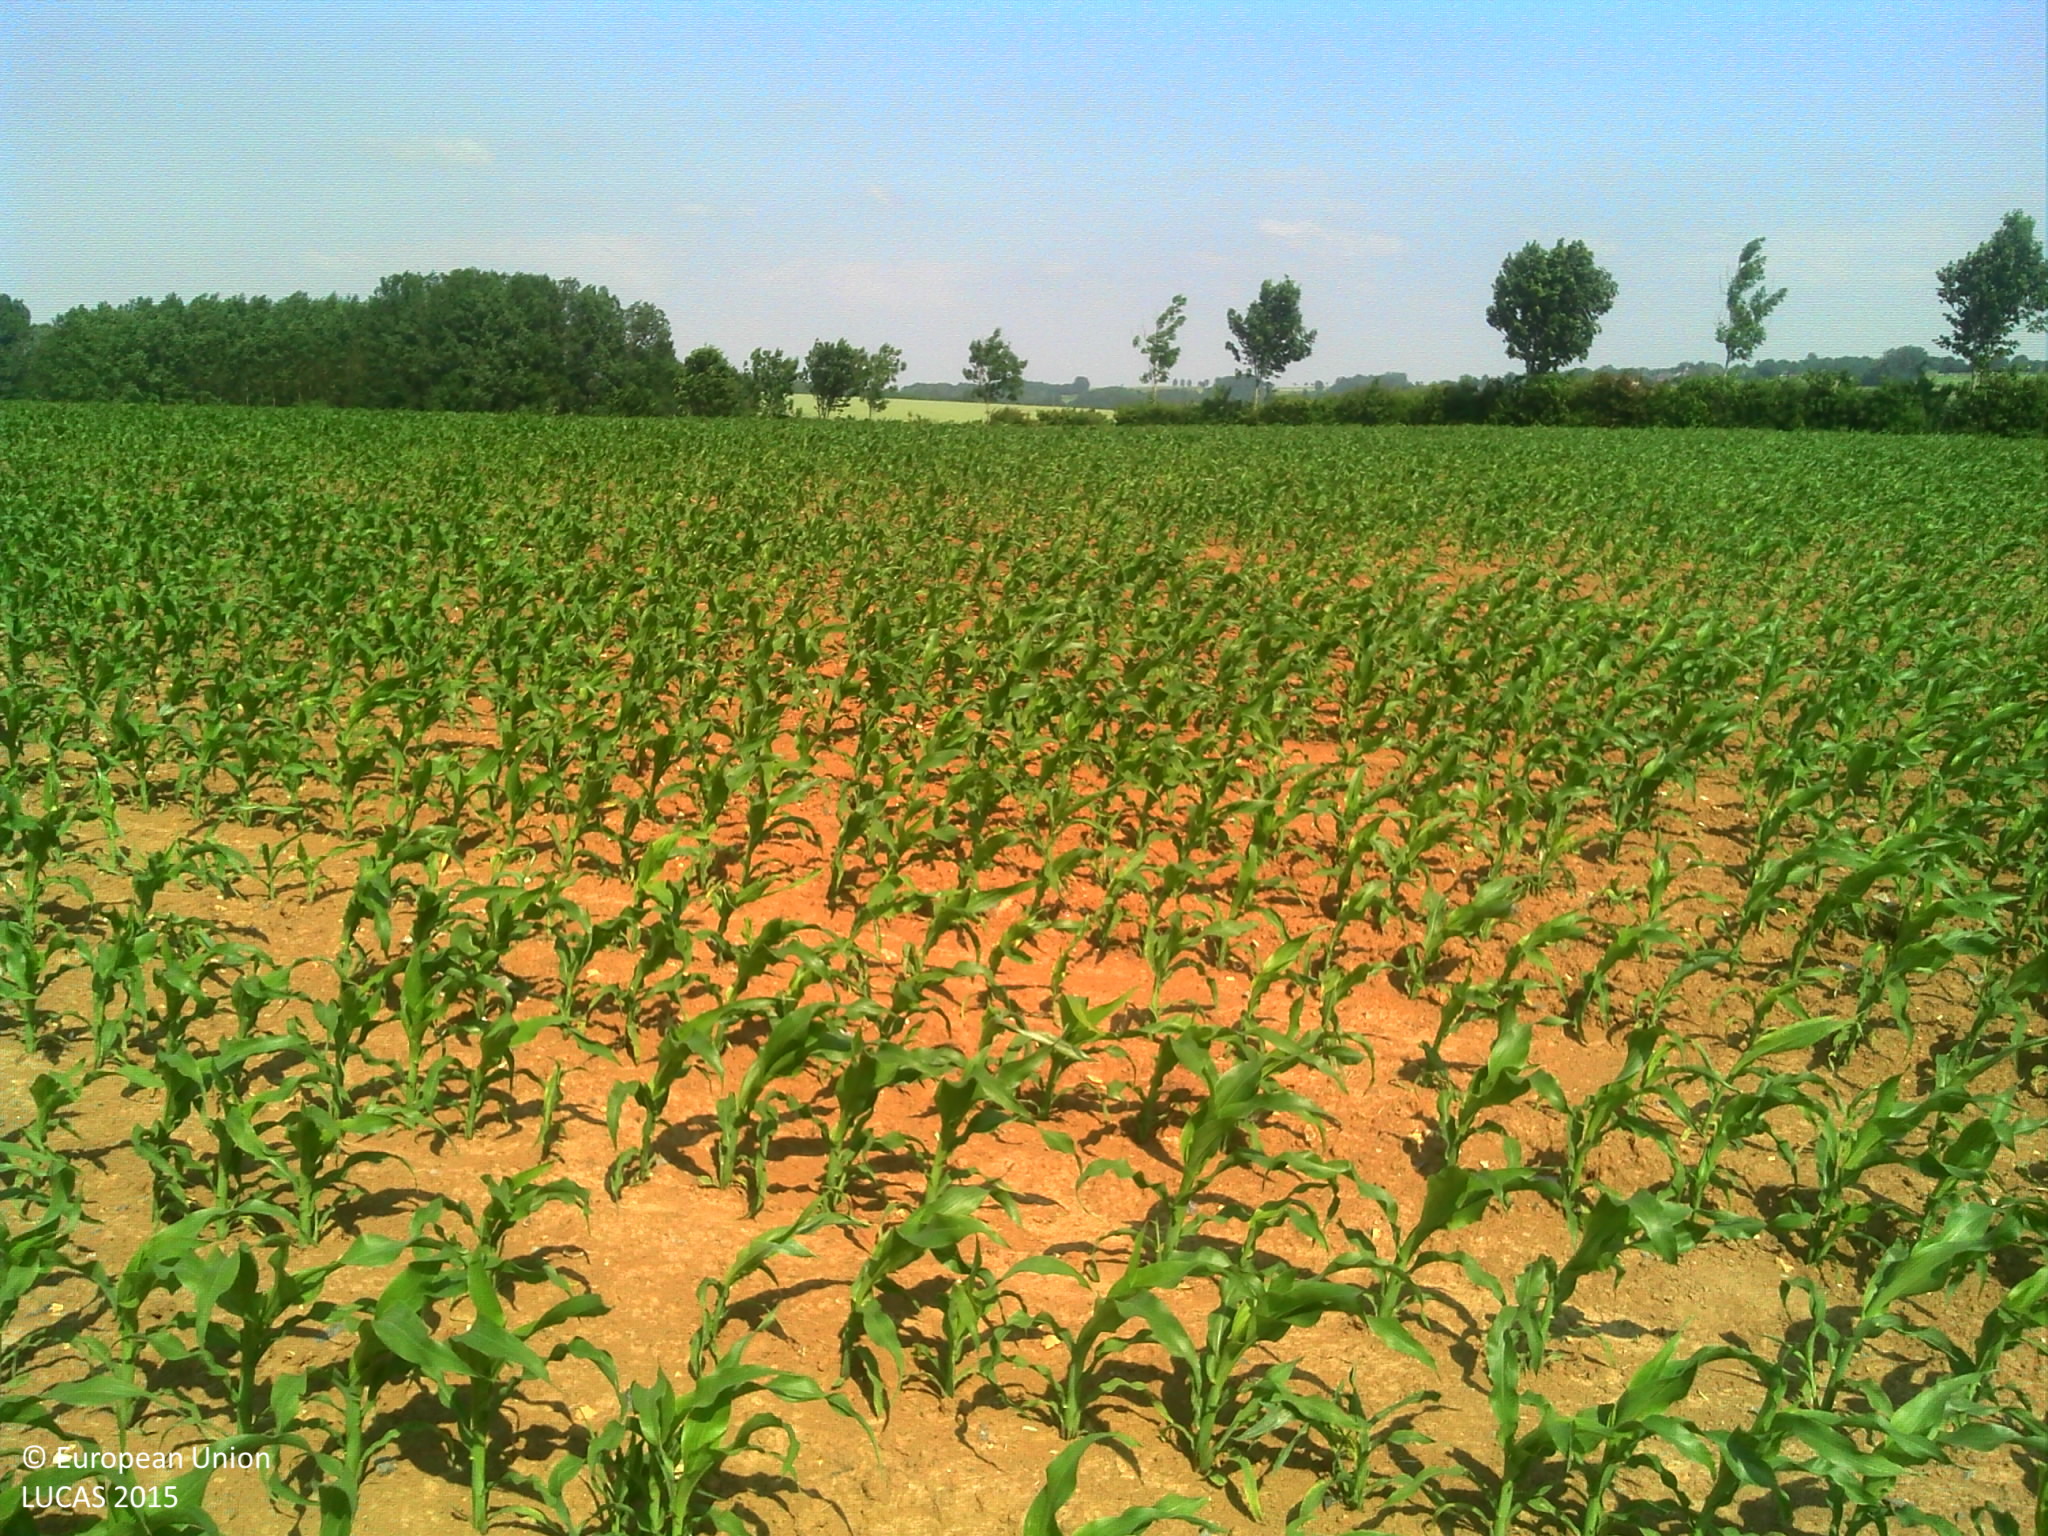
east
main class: Grassland
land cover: Grassland without tree/shrub cover
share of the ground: > 75 %
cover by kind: herbaceous plants 100 %
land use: Agriculture (excluding fallow land and kitchen gardens)
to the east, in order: Grassland without tree/shrub cover; Fences; Maize; Abandoned hedges; Grass margins; Paved roads, cycling and walking lanes; Grass margins; Common wheat
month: June
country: FR
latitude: 49.7443
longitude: 4.1248
